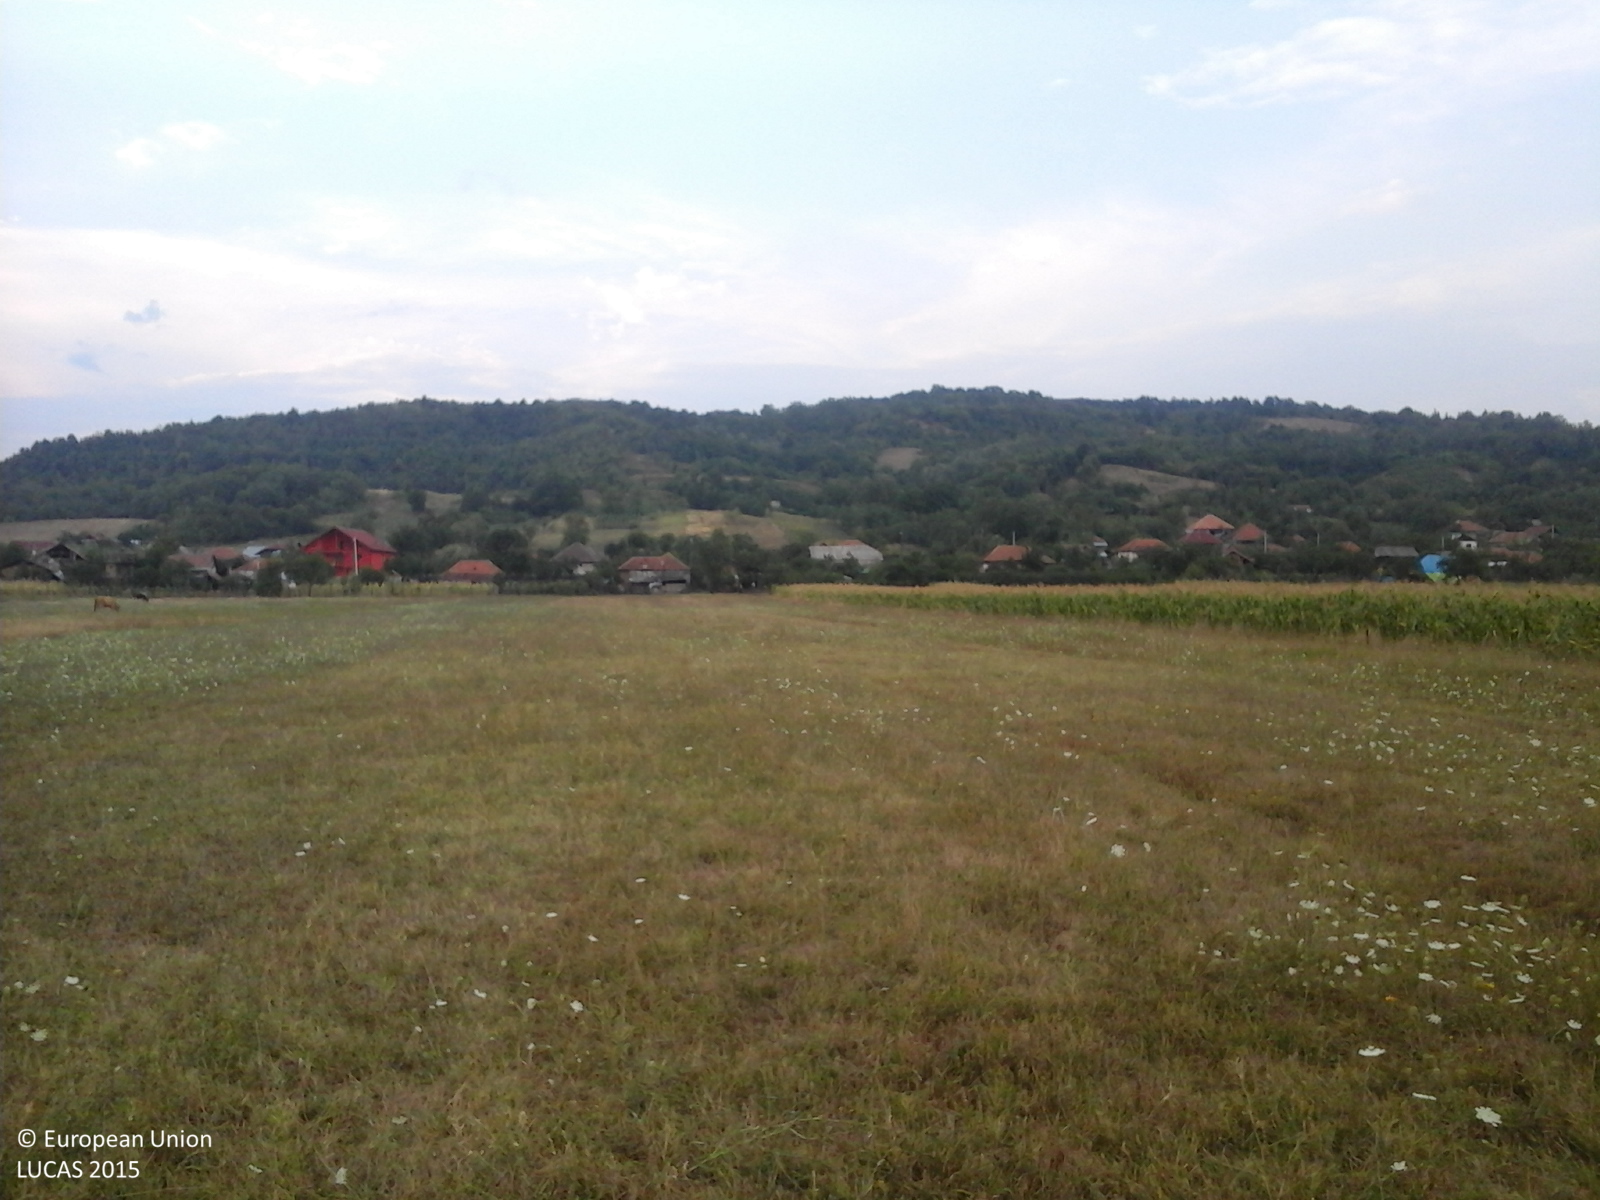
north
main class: Grassland
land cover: Grassland without tree/shrub cover
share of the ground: > 75 %
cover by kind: herbaceous plants 100 %
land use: Agriculture (excluding fallow land and kitchen gardens)
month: August
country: RO
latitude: 44.6927
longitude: 23.0320
